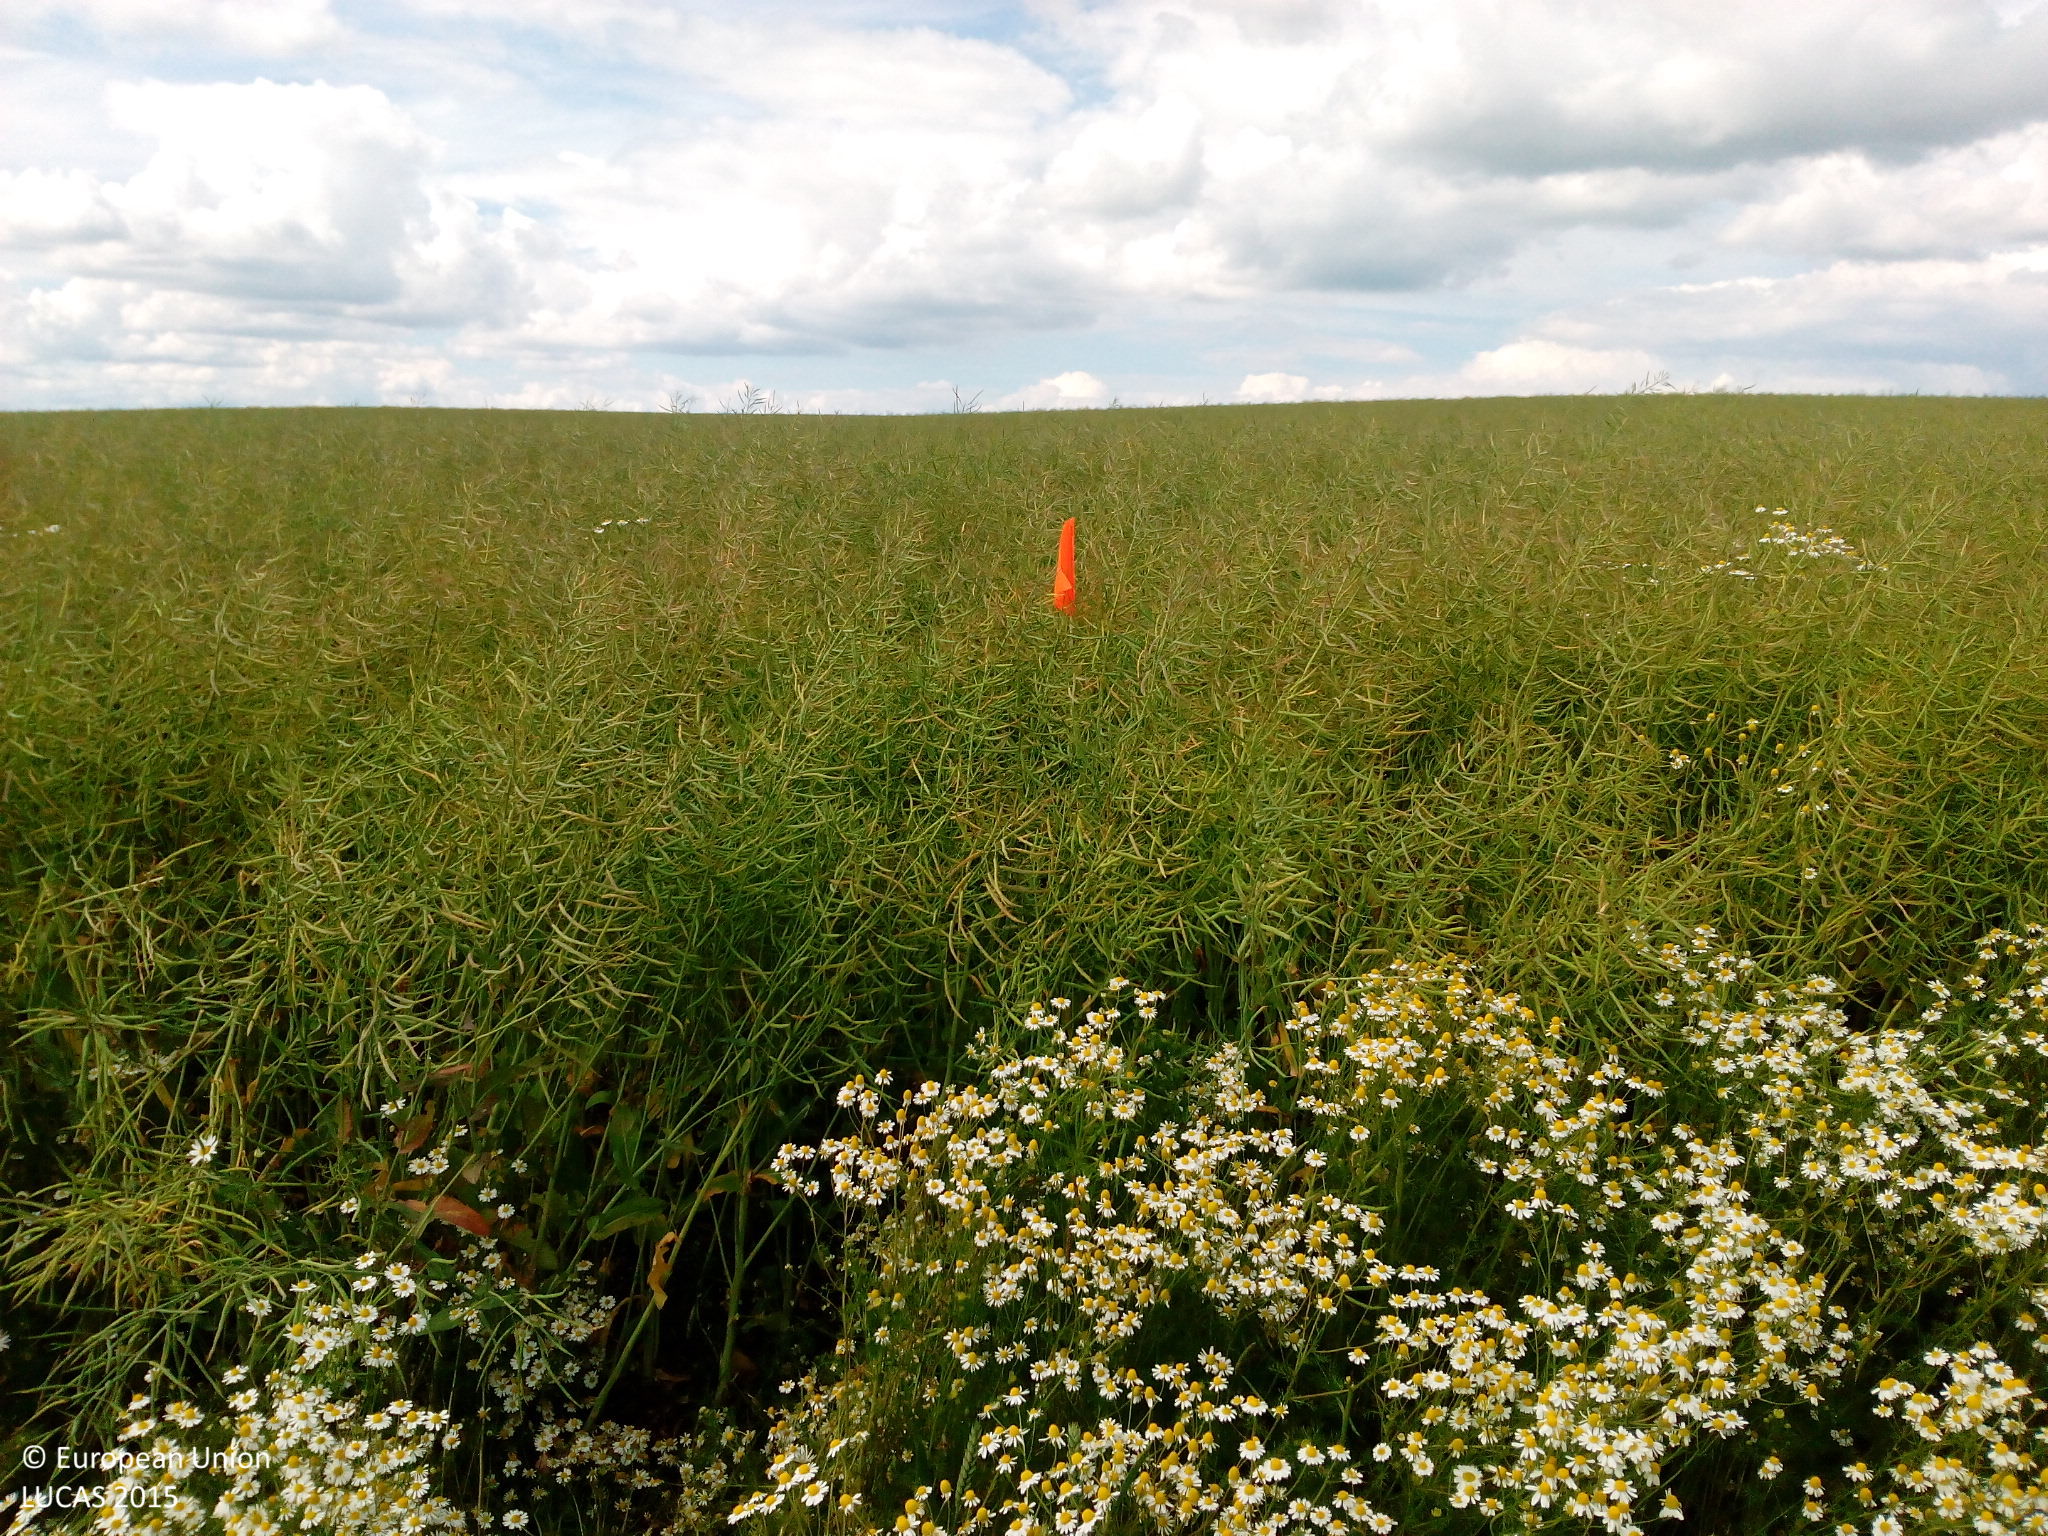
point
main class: Cropland
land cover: Rape and turnip rape
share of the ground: > 75 %
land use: Agriculture (excluding fallow land and kitchen gardens)
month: June
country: DE
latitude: 53.8465
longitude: 11.0786
